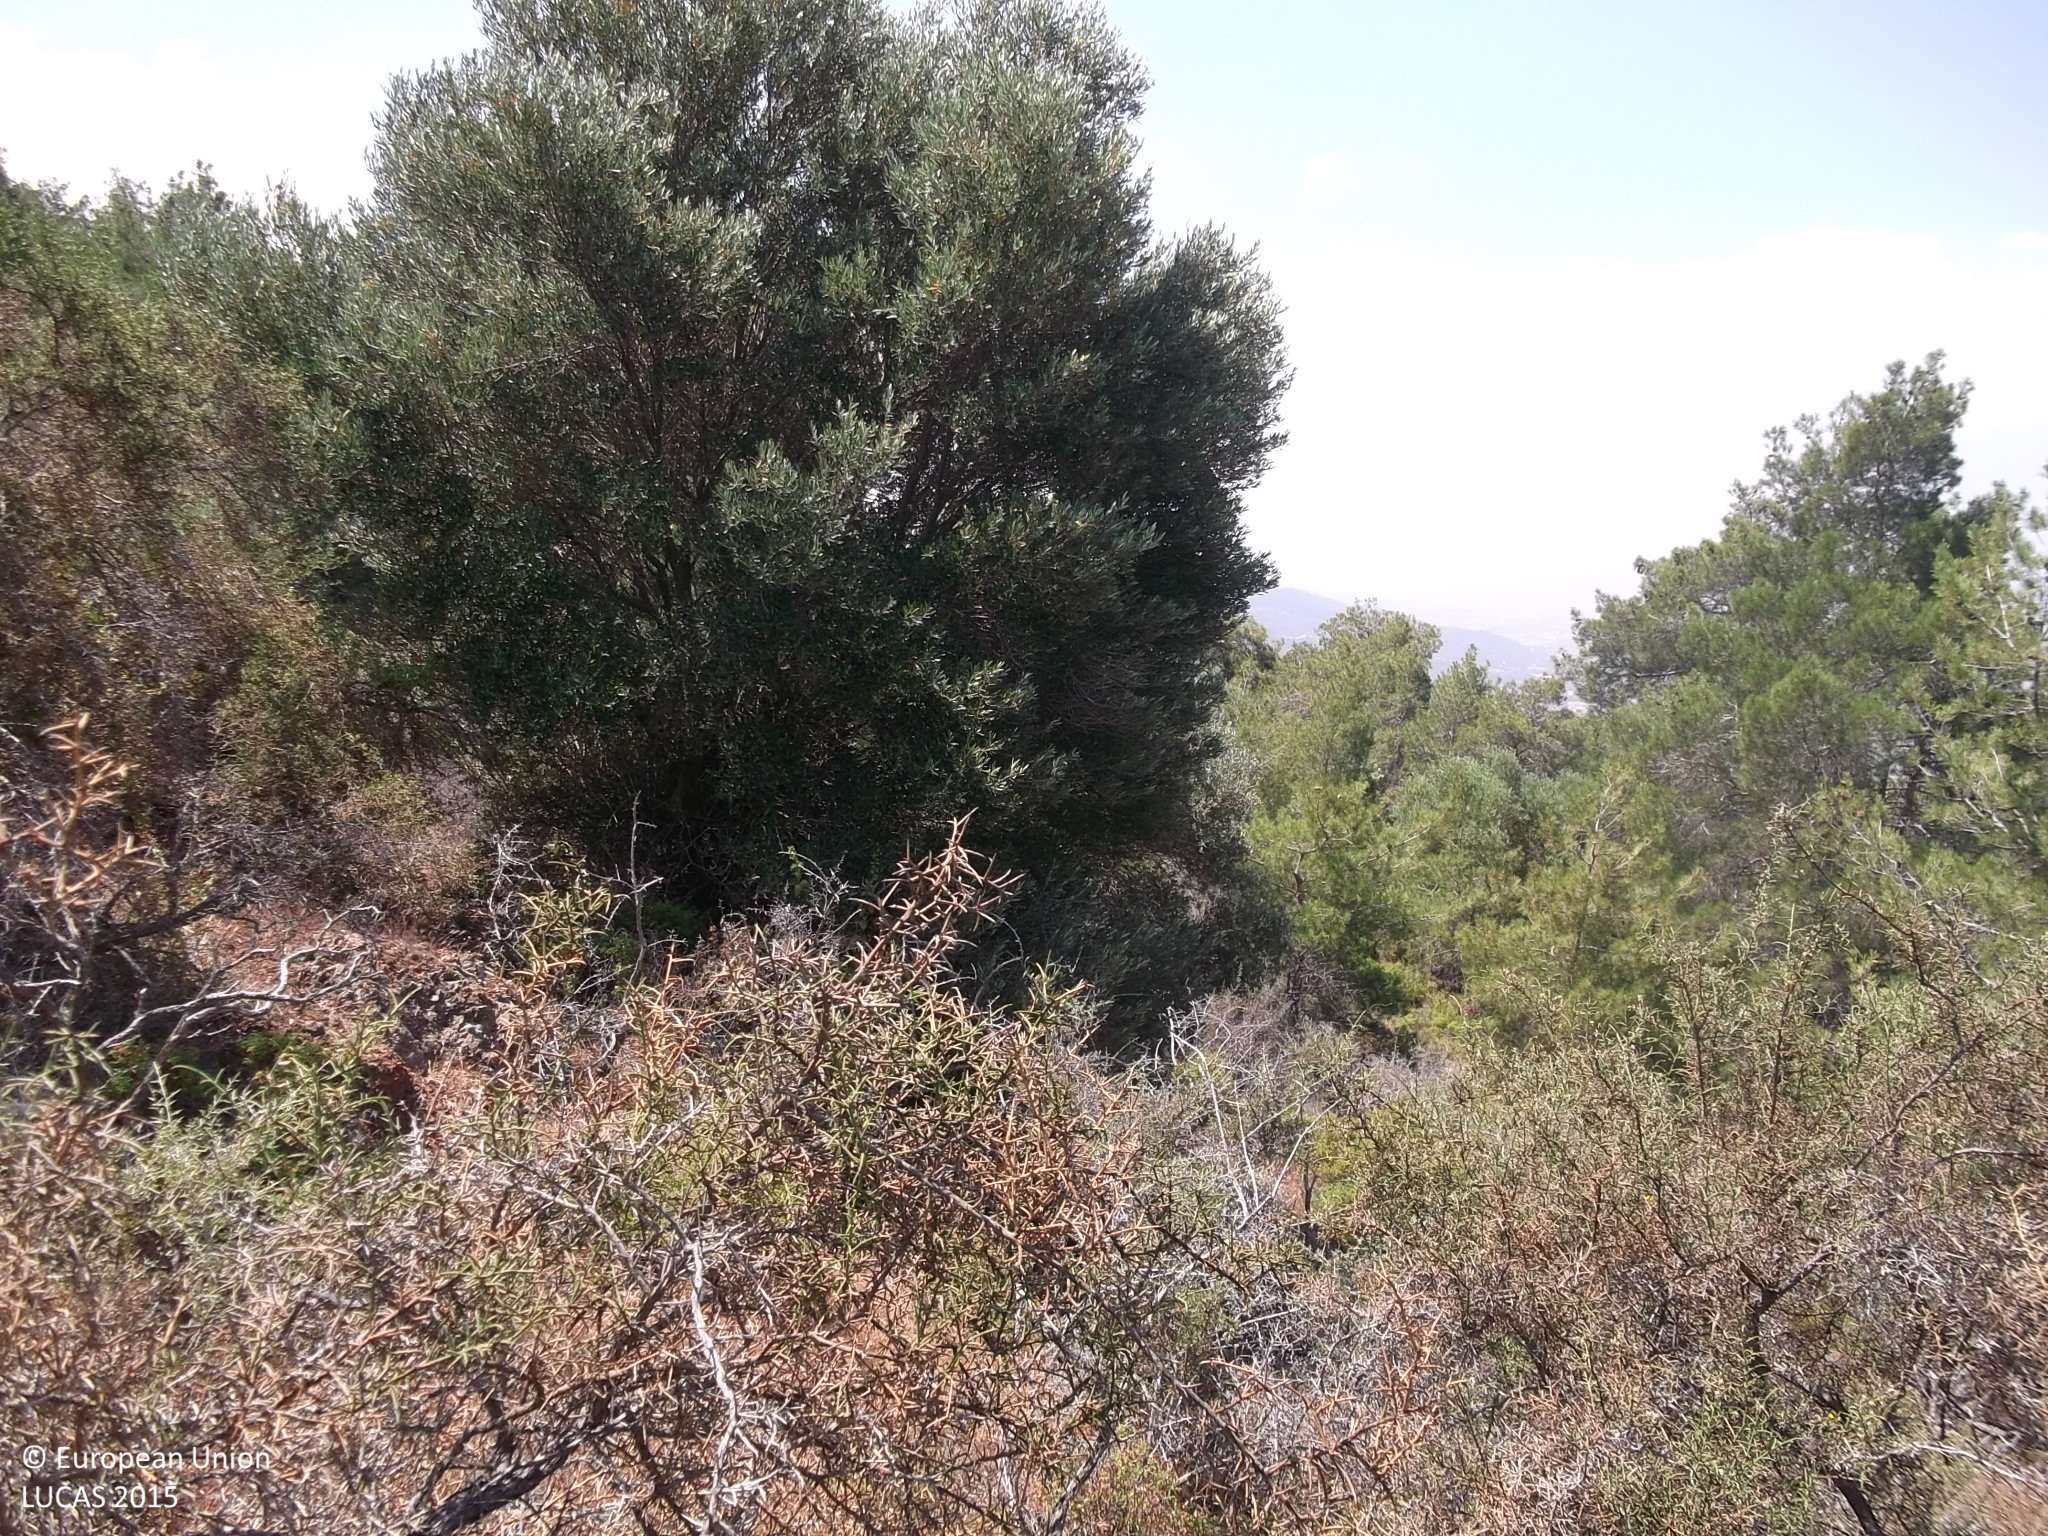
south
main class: Woodland
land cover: Pine dominated mixed woodland
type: coniferous forest of the mediterranean region
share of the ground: > 75 %
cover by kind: coniferous forest trees 55 %, broadleaved forest trees 25 %, shrubs 10 %, unconsolidated bare surface 10 %
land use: Forestry
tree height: > 5 m
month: June
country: CY
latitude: 35.1355
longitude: 32.5385
